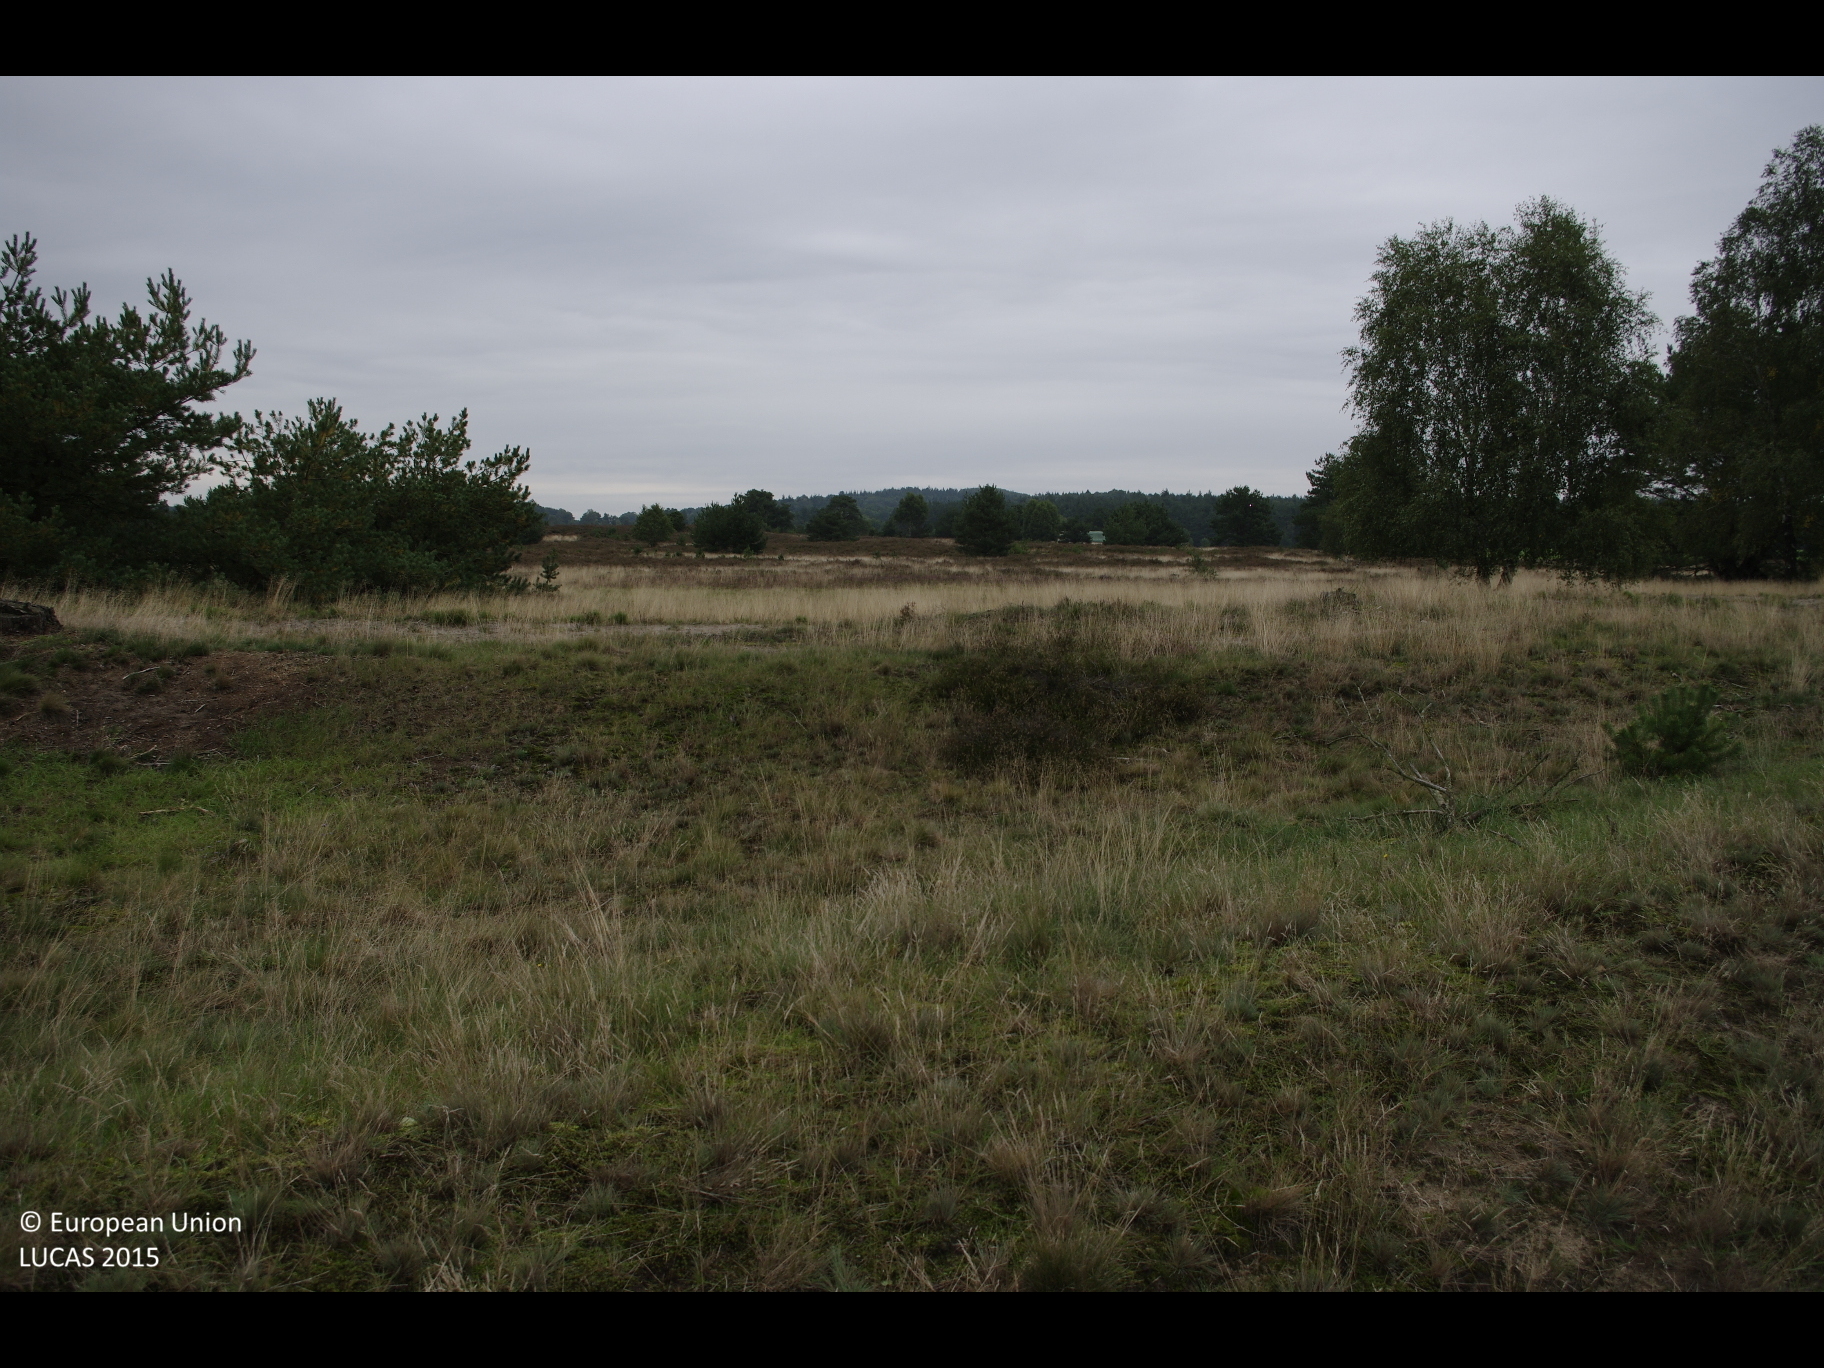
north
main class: Woodland
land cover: Pine dominated coniferous woodland
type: hemiboreal forest and nemoral coniferous forest and mixed broadleaved-coniferous forest
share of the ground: 50 - 75 %
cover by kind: coniferous forest trees 60 %, shrubs 40 %
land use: Forestry
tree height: > 5 m
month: September
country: DE
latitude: 53.1323
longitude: 9.9253
